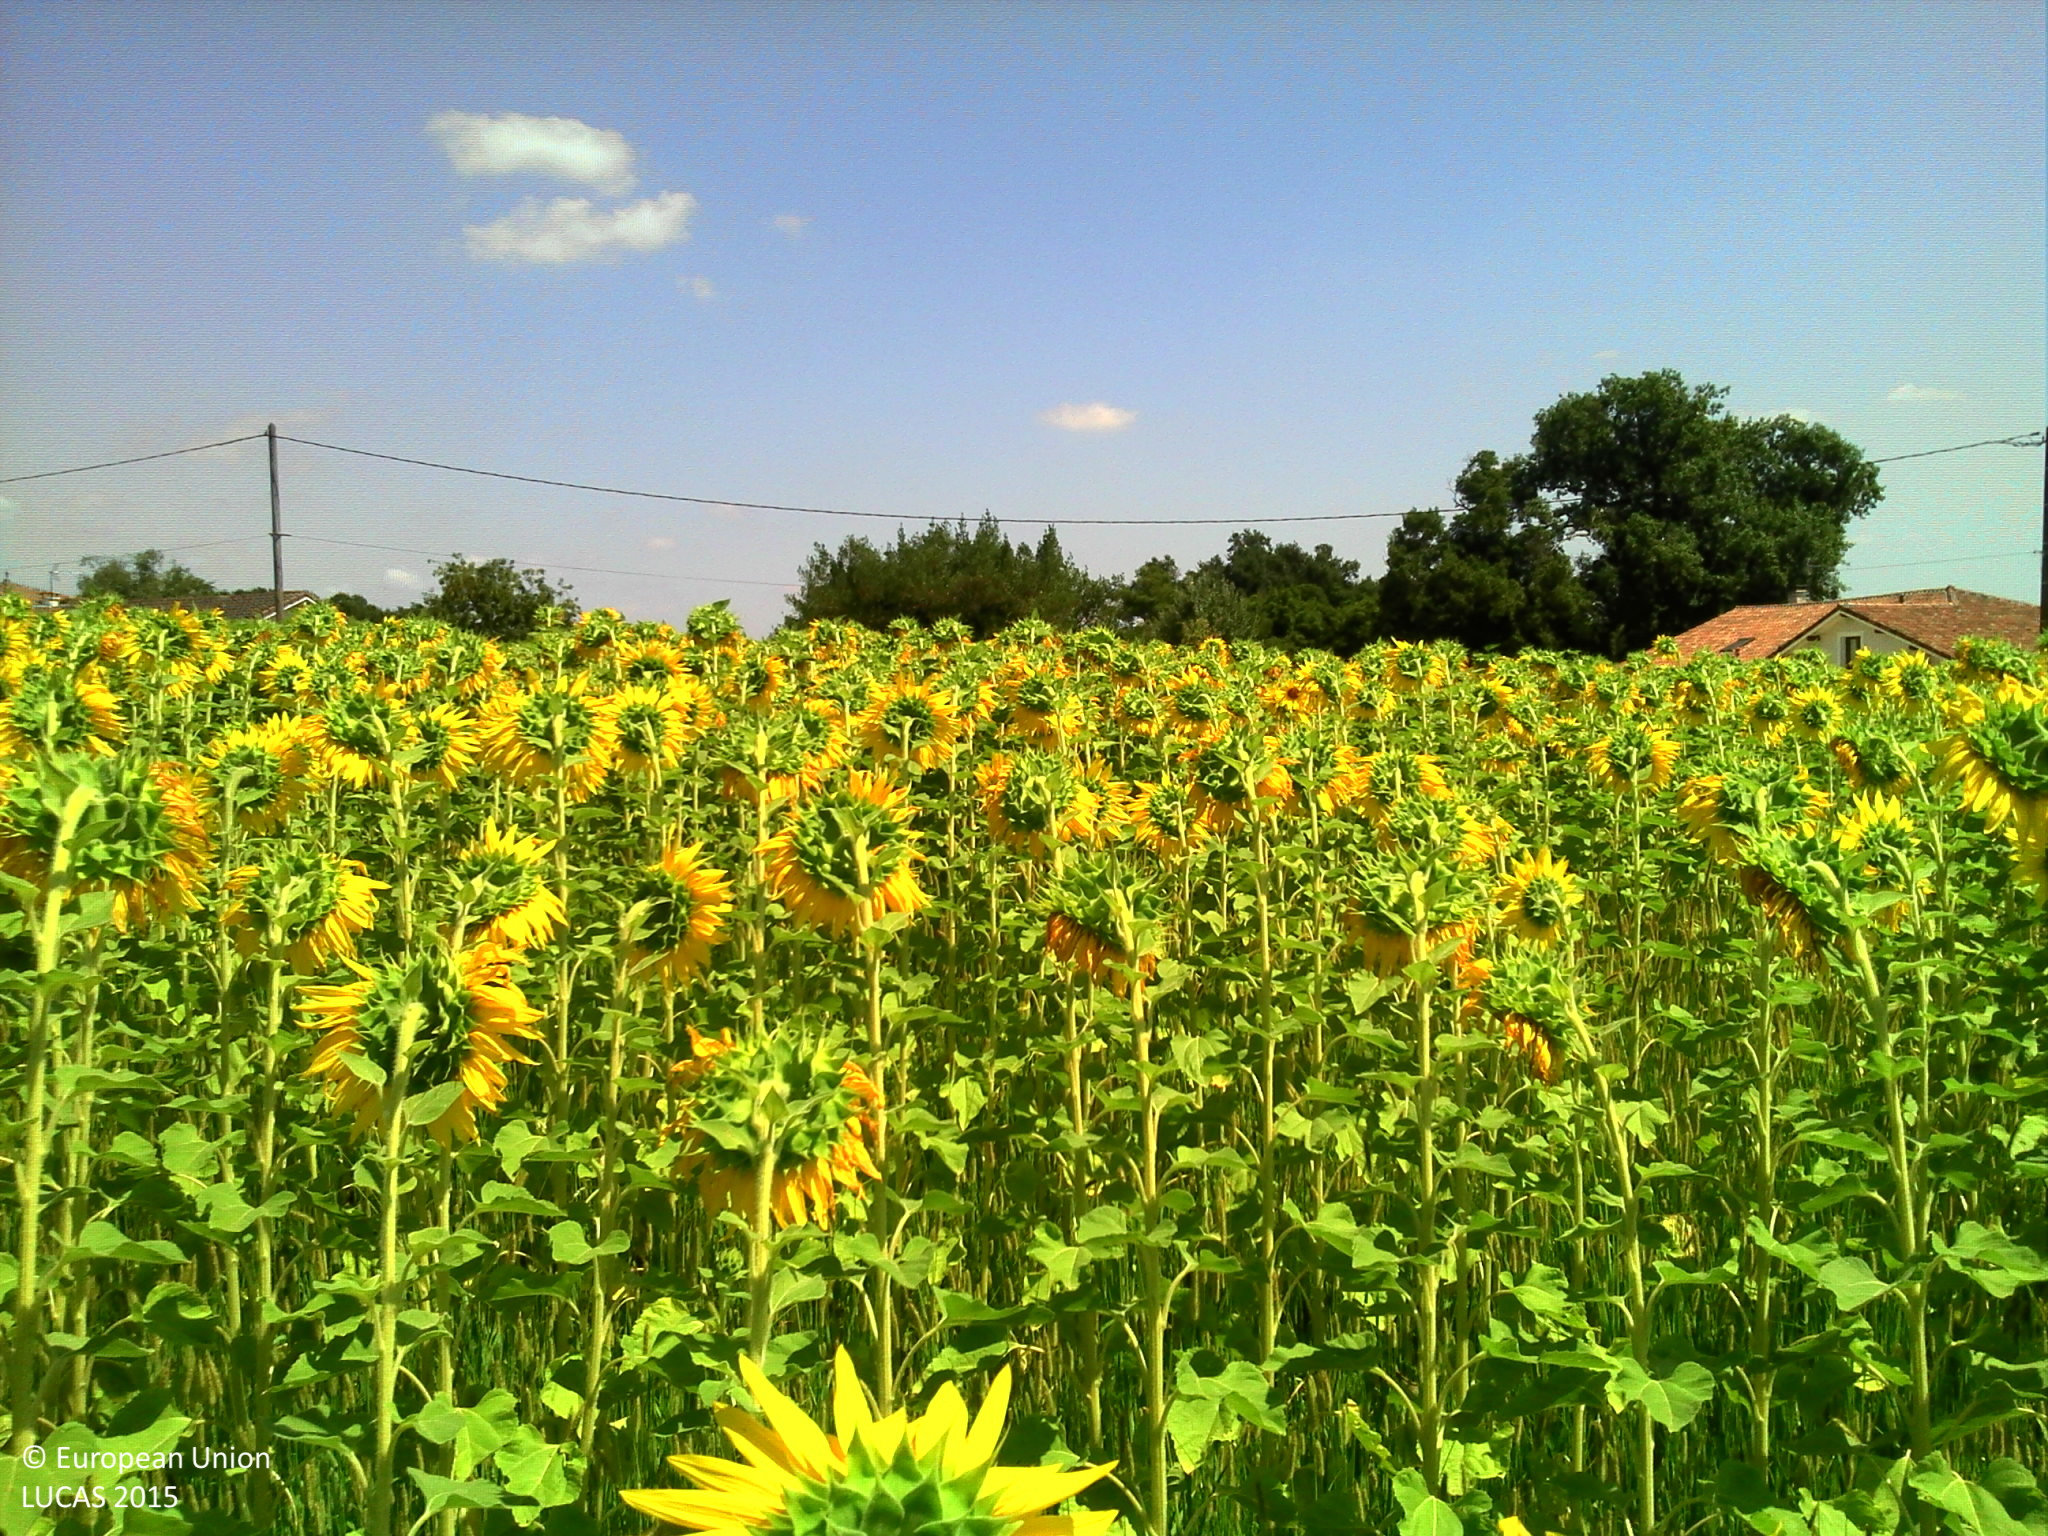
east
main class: Cropland
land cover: Sunflower
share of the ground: > 75 %
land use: Agriculture (excluding fallow land and kitchen gardens)
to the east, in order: Sunflower; Shruby margins; Electric lines; Artificial constructions in urban areas; Grassland without tree/shrub cover; Paved roads, cycling and walking lanes; Grassland without tree/shrub cover; Tracks; Sunflower
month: August
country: FR
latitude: 43.7383
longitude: -0.5528
